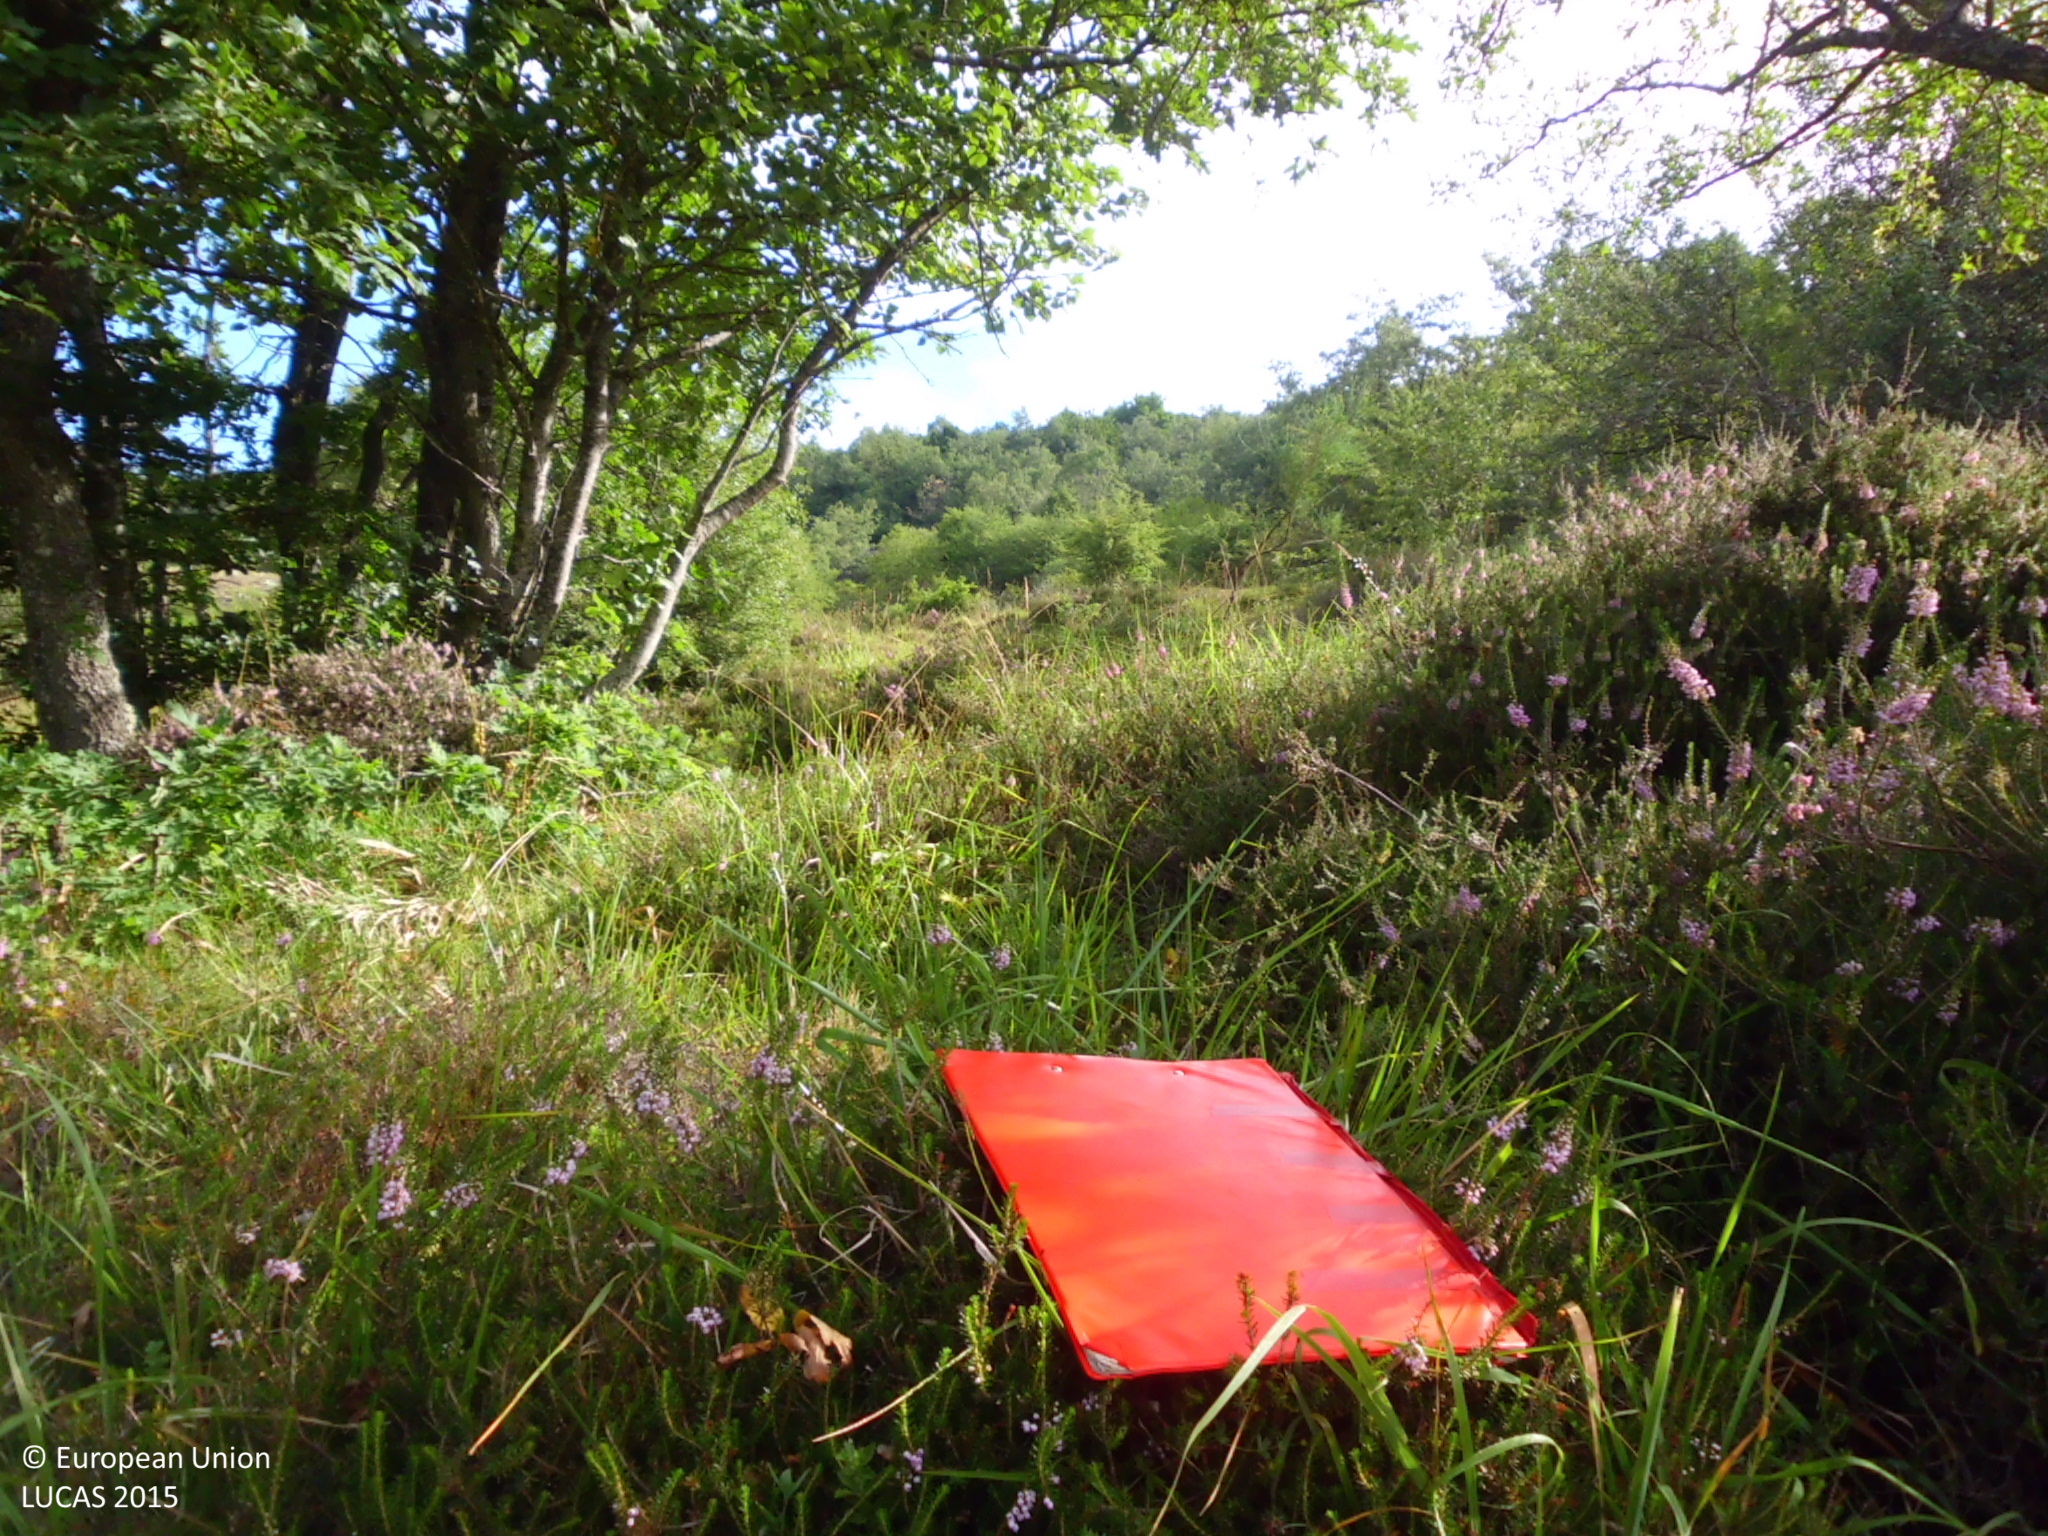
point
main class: Shrubland
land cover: Shrubland with sparse tree cover
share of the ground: 25 - 50 %
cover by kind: herbaceous plants 50 %, shrubs 45 %, broadleaved forest trees 5 %
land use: Agriculture (excluding fallow land and kitchen gardens)
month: July
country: ES
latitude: 42.9937
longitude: -4.5177
